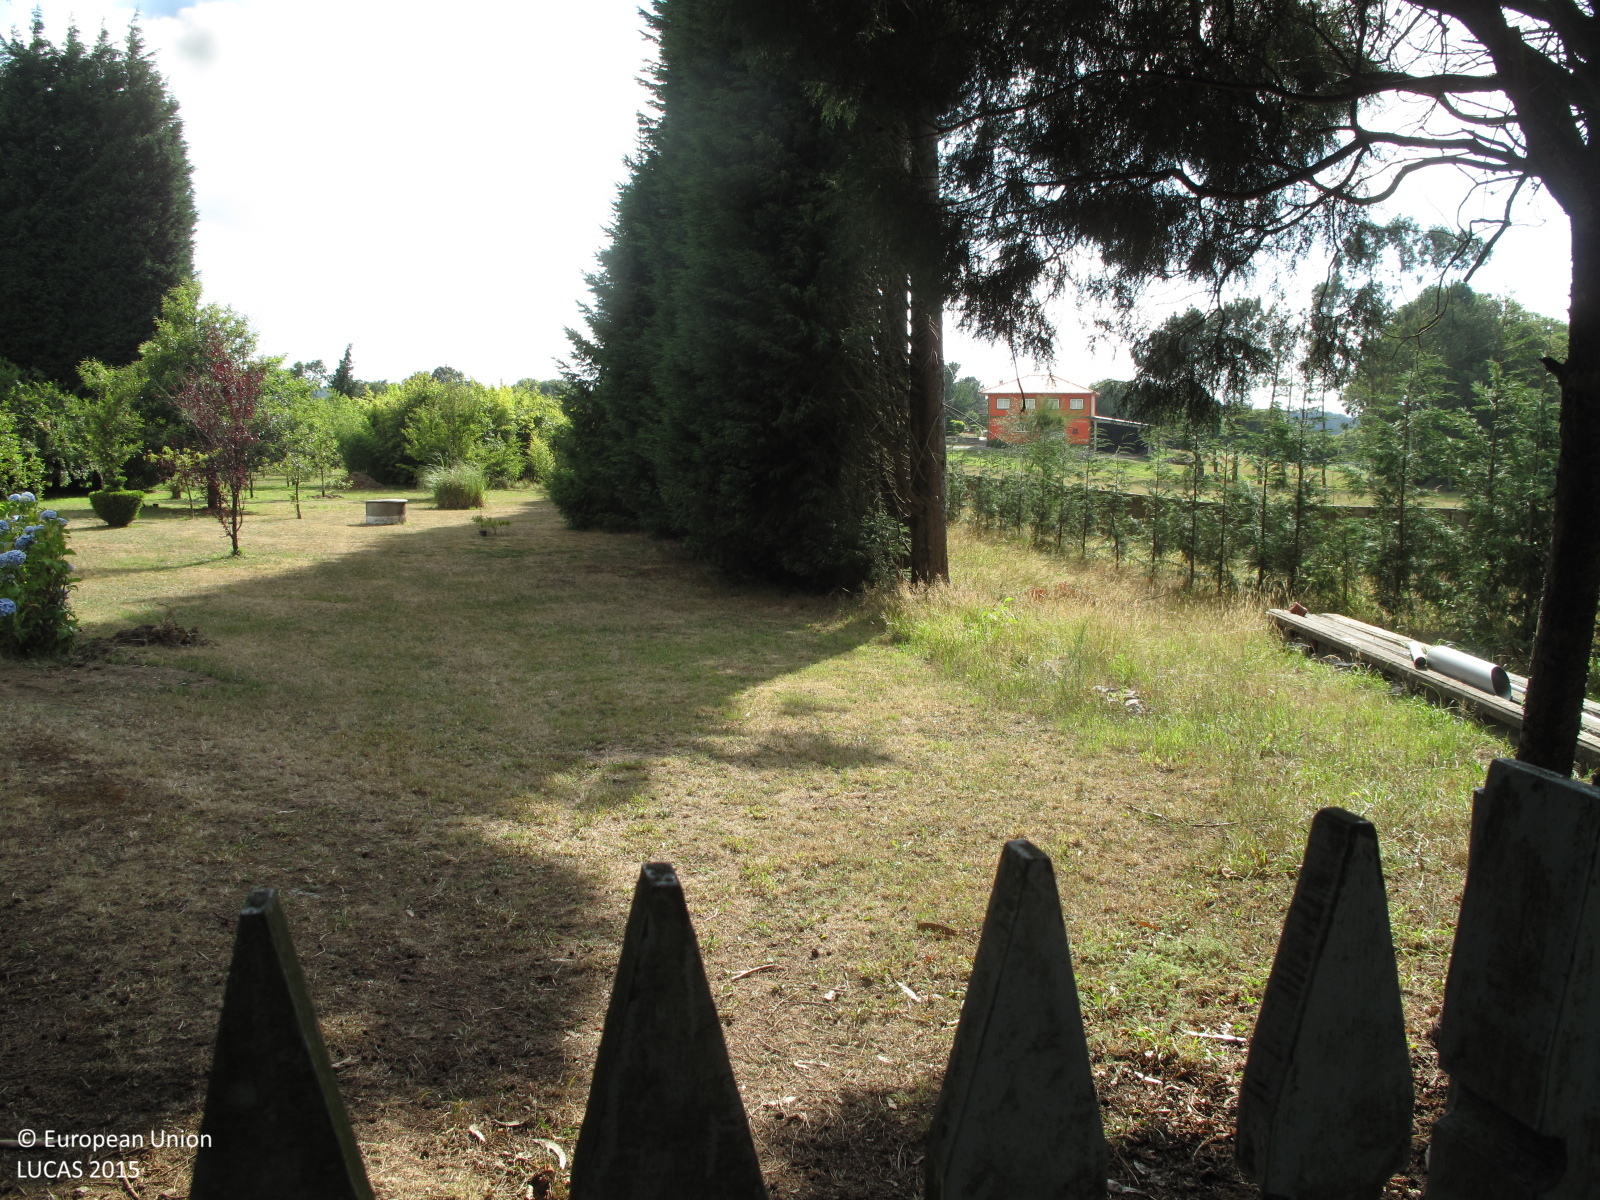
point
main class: Woodland
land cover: Other coniferous woodland
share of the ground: > 75 %
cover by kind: coniferous forest trees 80 %, shrubs 20 %
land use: Community services
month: July
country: ES
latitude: 43.0810
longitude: -7.9613
